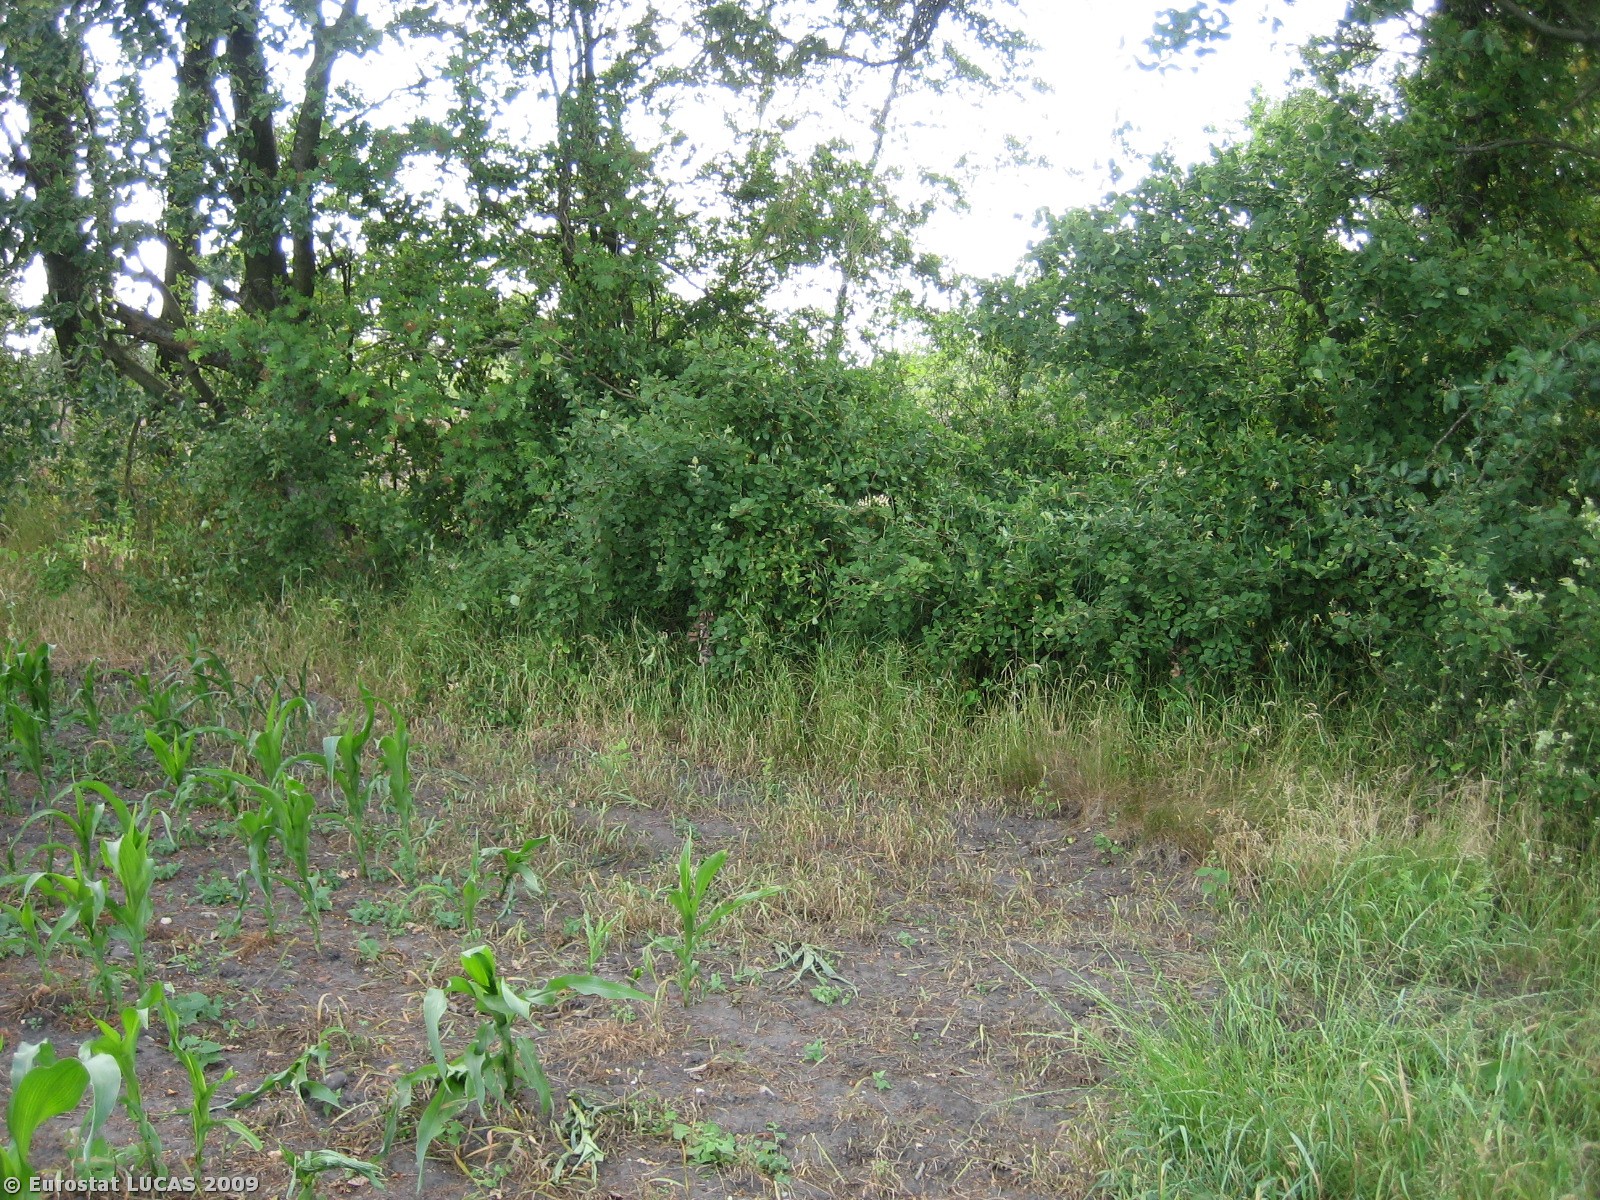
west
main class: Cropland
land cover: Barley
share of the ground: 25 - 50 %
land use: Agriculture (excluding fallow land and kitchen gardens)
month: July
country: DK
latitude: 55.7107
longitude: 8.4258
